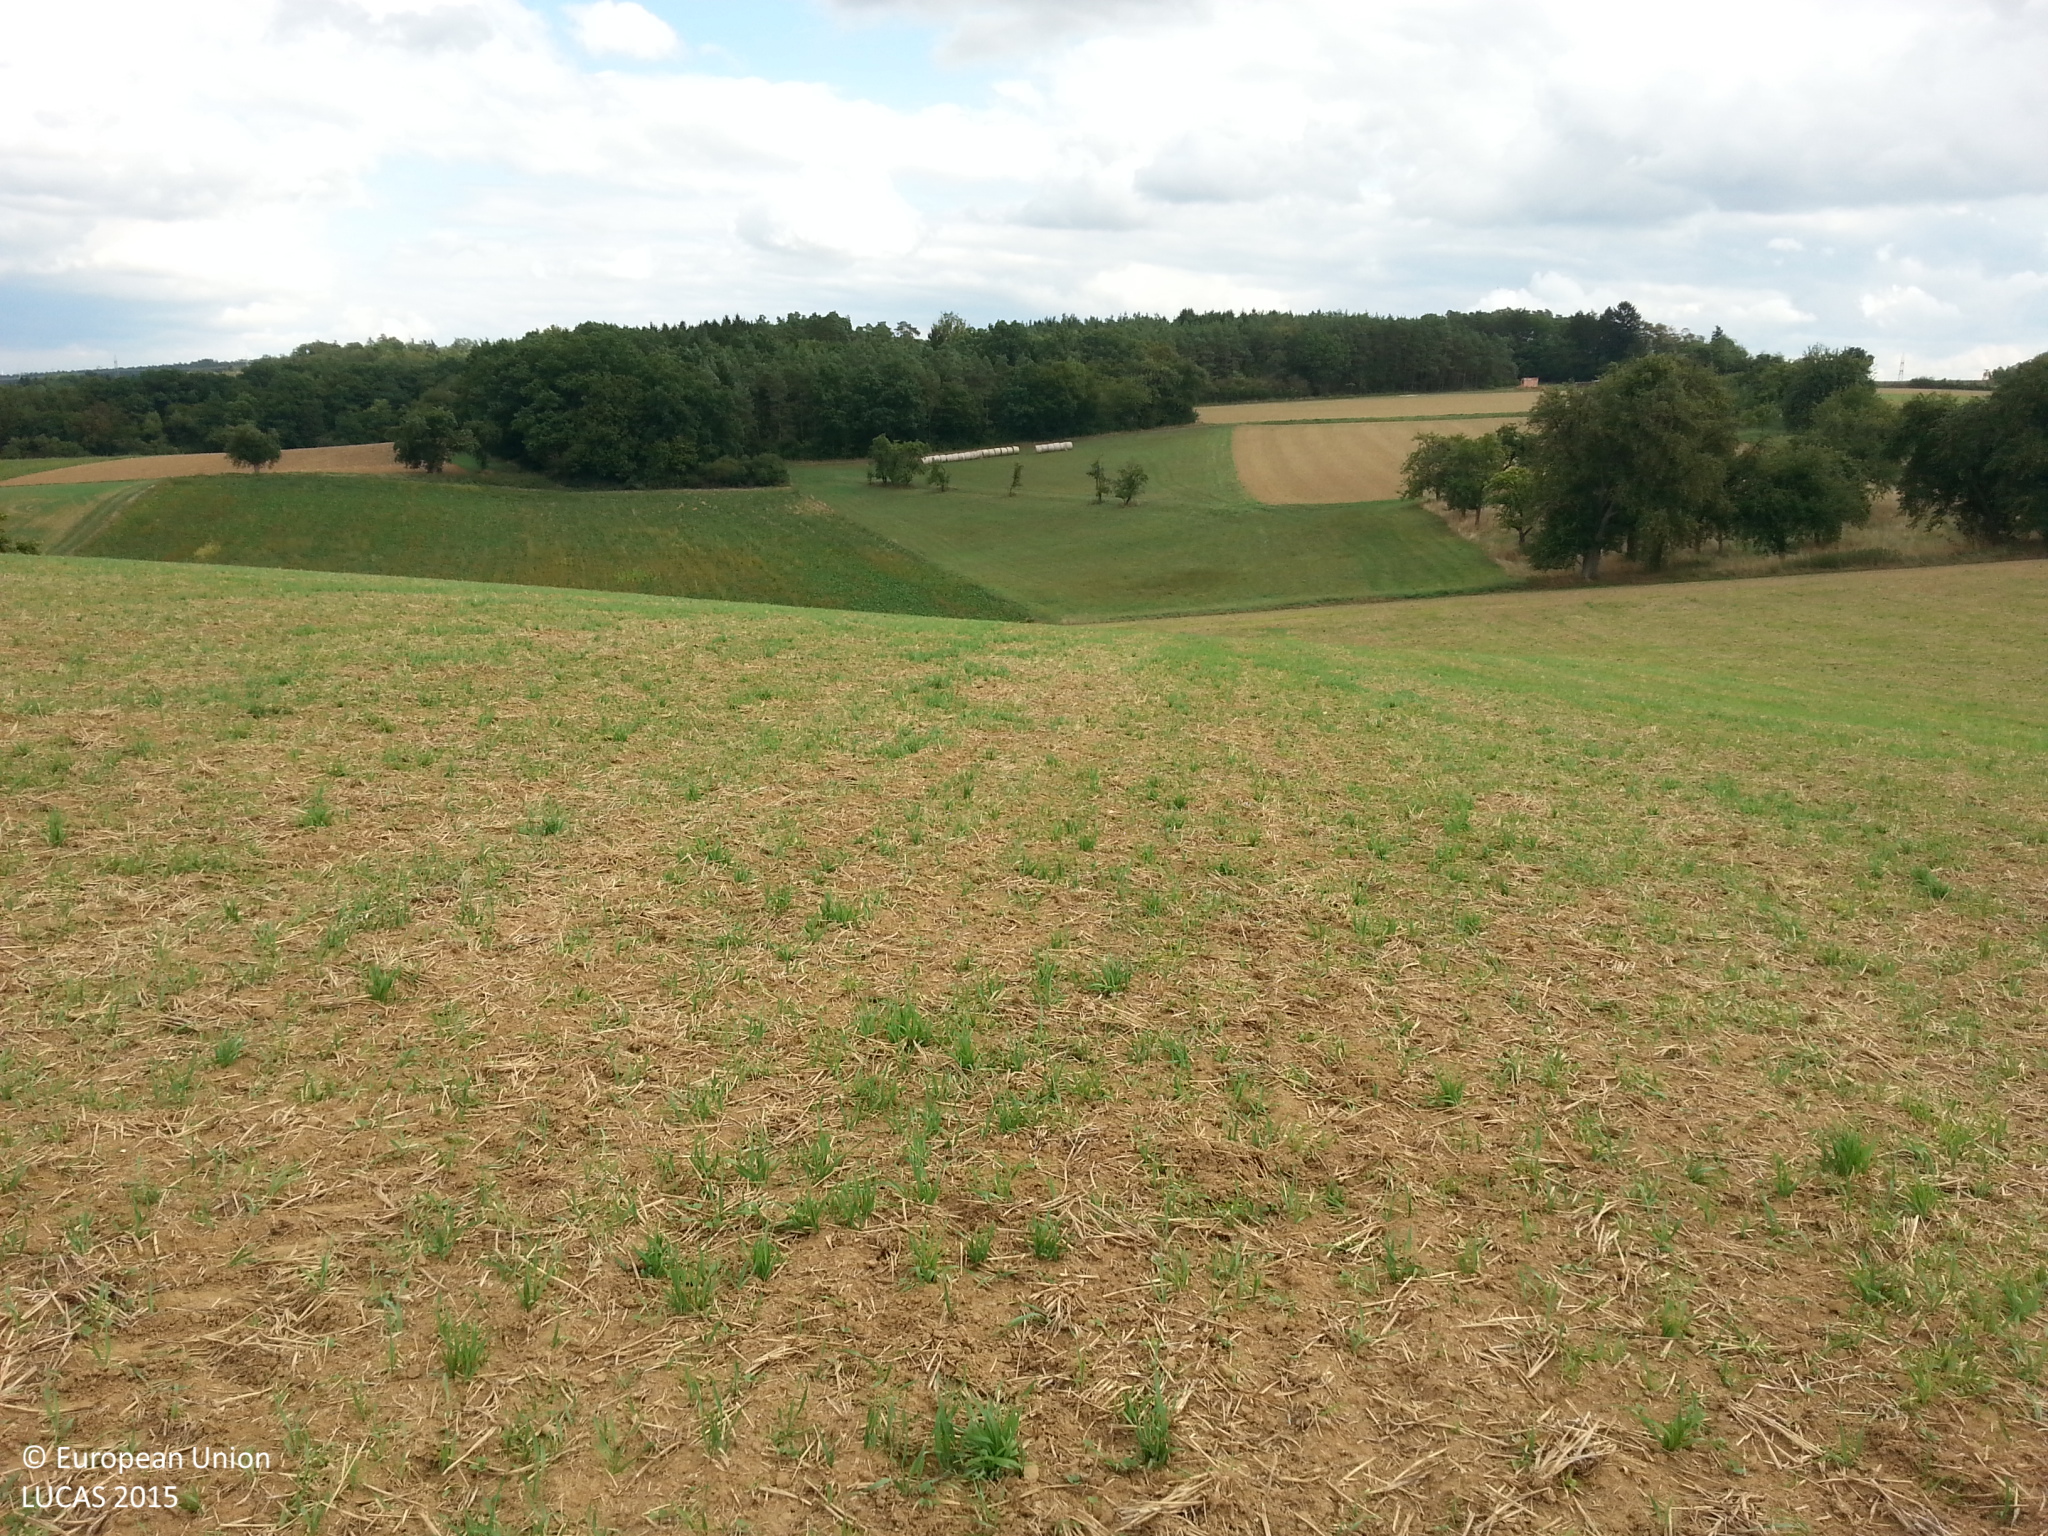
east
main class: Cropland
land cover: Rape and turnip rape
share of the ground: < 10 %
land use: Agriculture (excluding fallow land and kitchen gardens)
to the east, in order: Rape and turnip rape; Grassland without tree/shrub cover; Apple fruit; Grassland without tree/shrub cover; Cherry fruit; Apple fruit; Rape and turnip rape
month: September
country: DE
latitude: 49.3914
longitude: 9.4078
